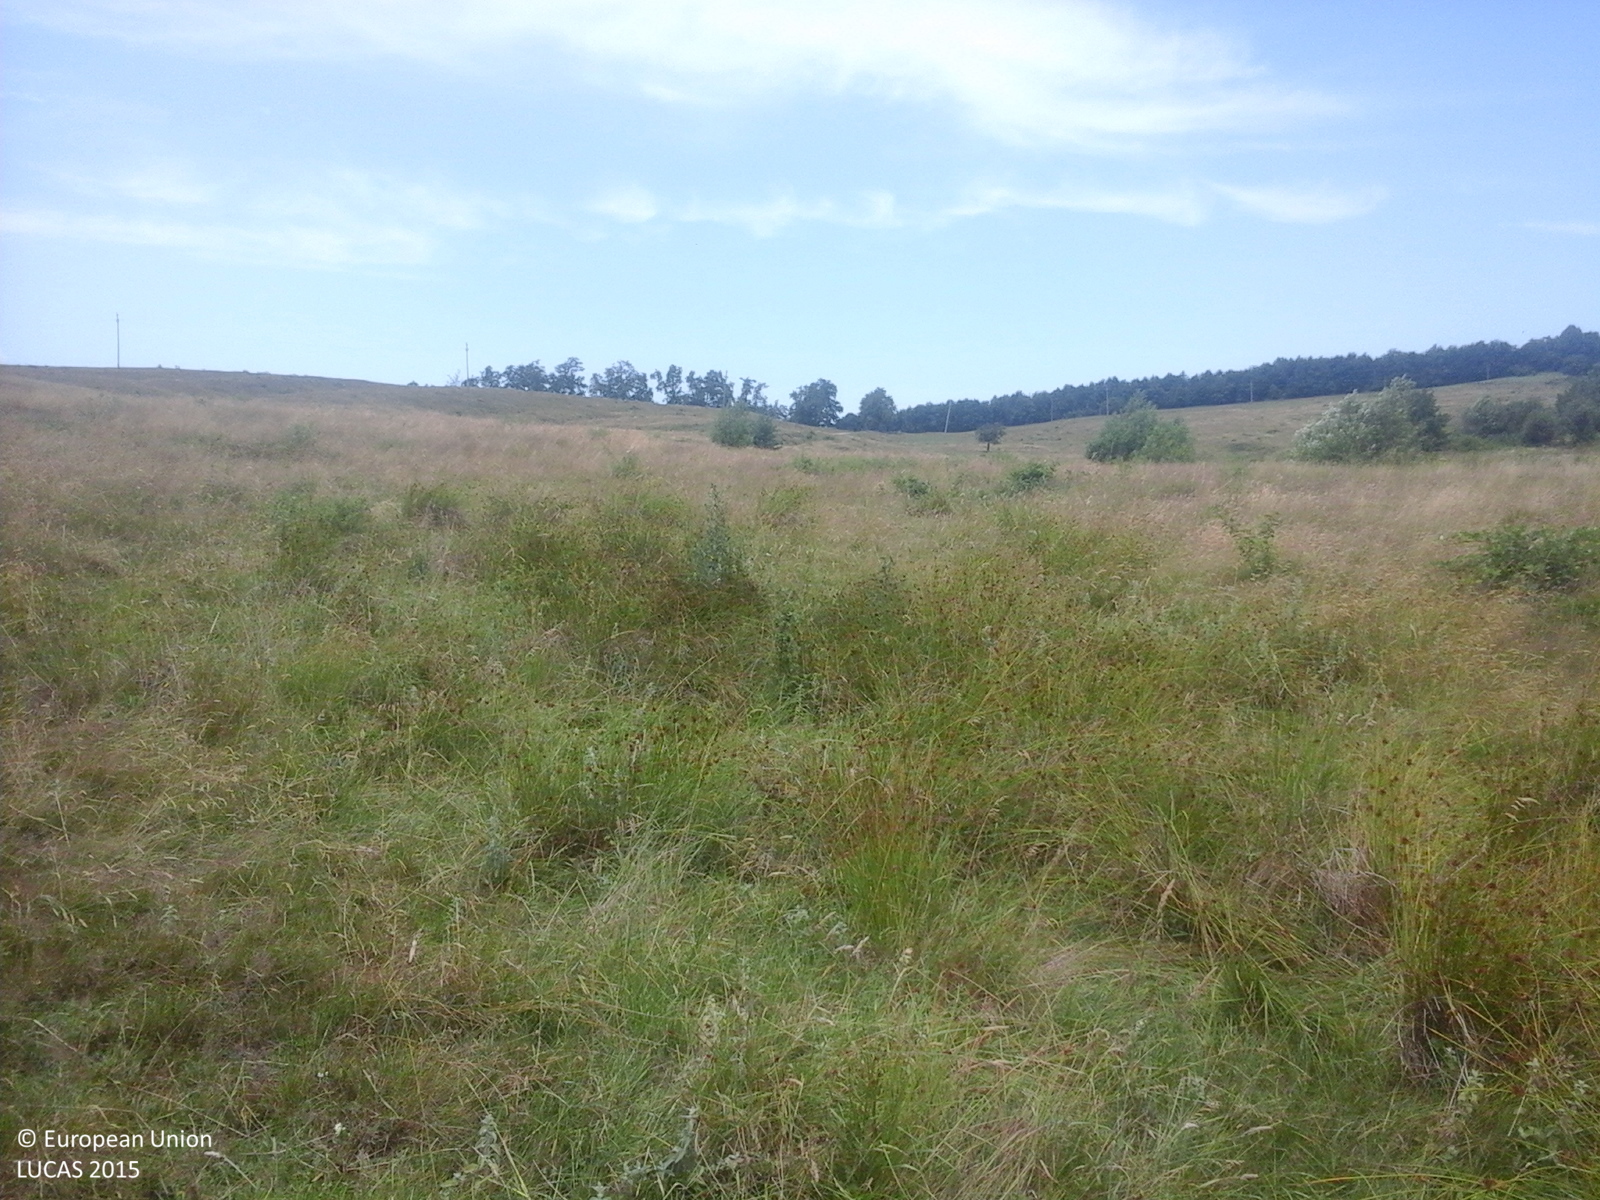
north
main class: Grassland
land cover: Grassland without tree/shrub cover
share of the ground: > 75 %
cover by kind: herbaceous plants 100 %
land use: Agriculture (excluding fallow land and kitchen gardens)
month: July
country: RO
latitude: 45.2171
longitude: 24.5829
